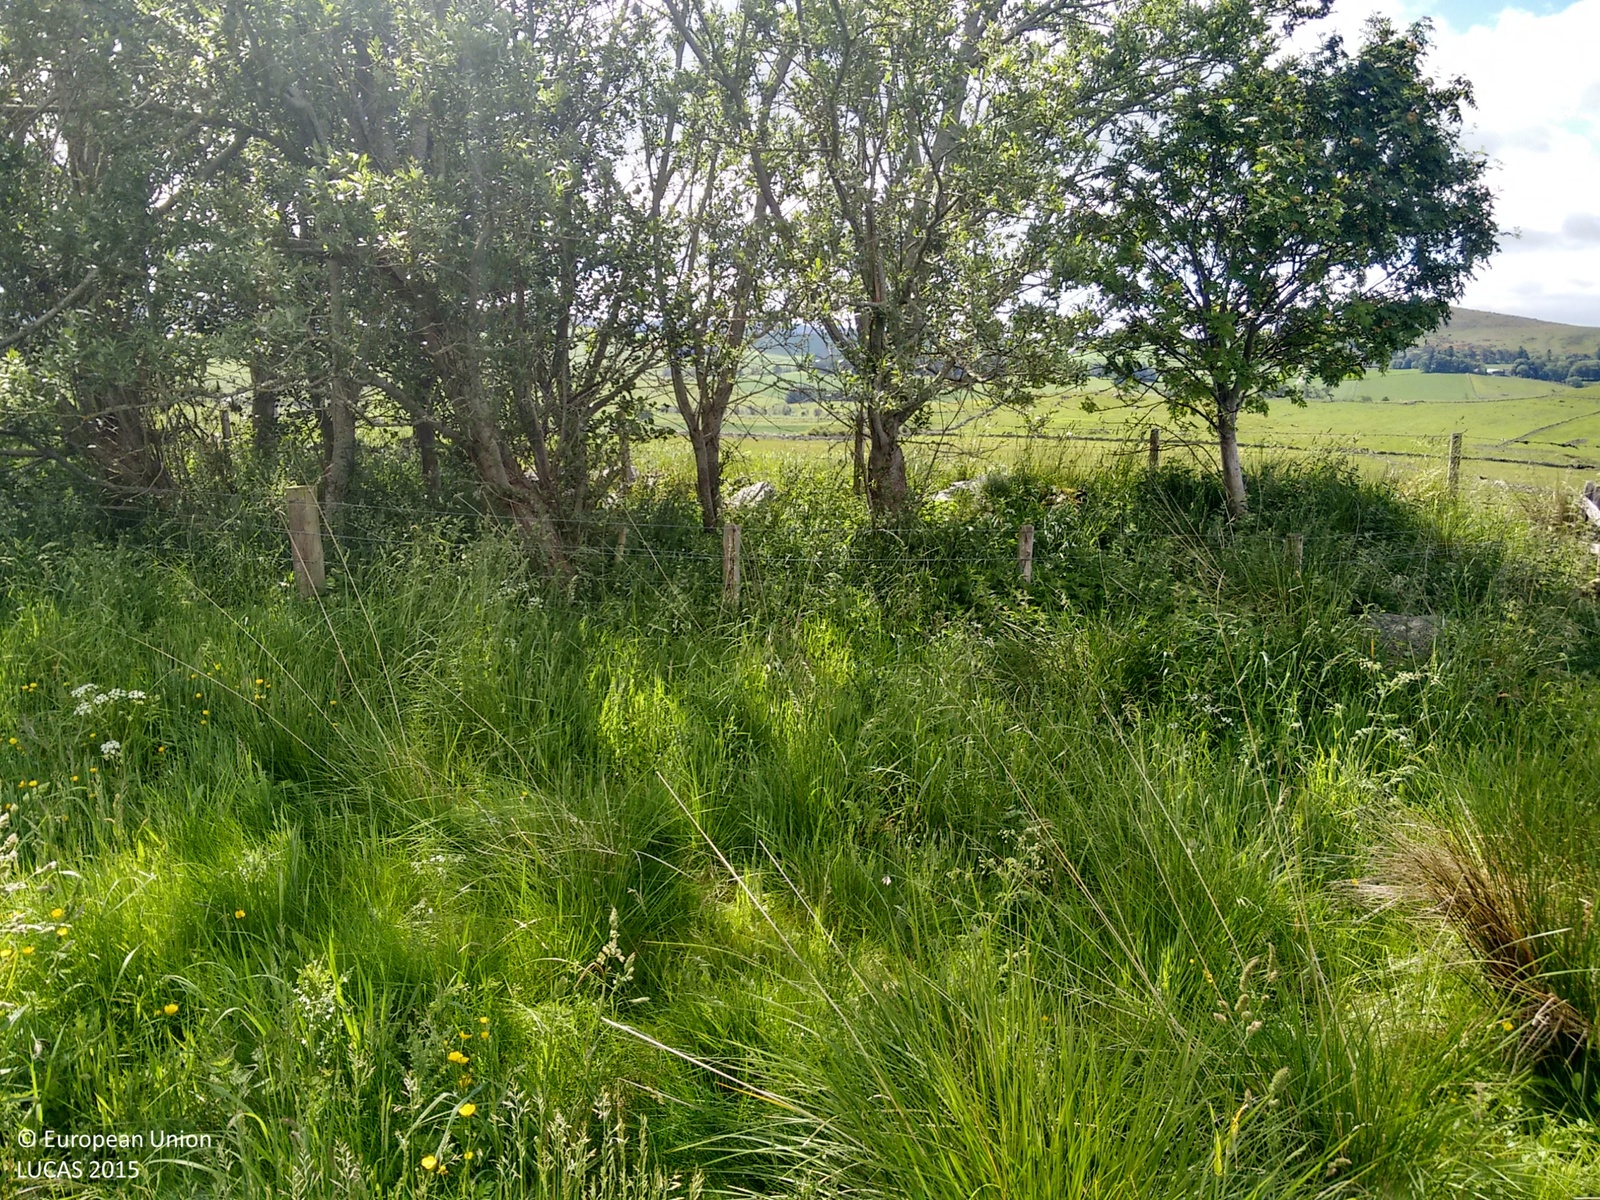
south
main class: Grassland
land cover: Grassland without tree/shrub cover
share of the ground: > 75 %
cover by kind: herbaceous plants 100 %
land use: Agriculture (excluding fallow land and kitchen gardens)
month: June
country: GB
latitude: 57.3419
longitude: -2.8702
